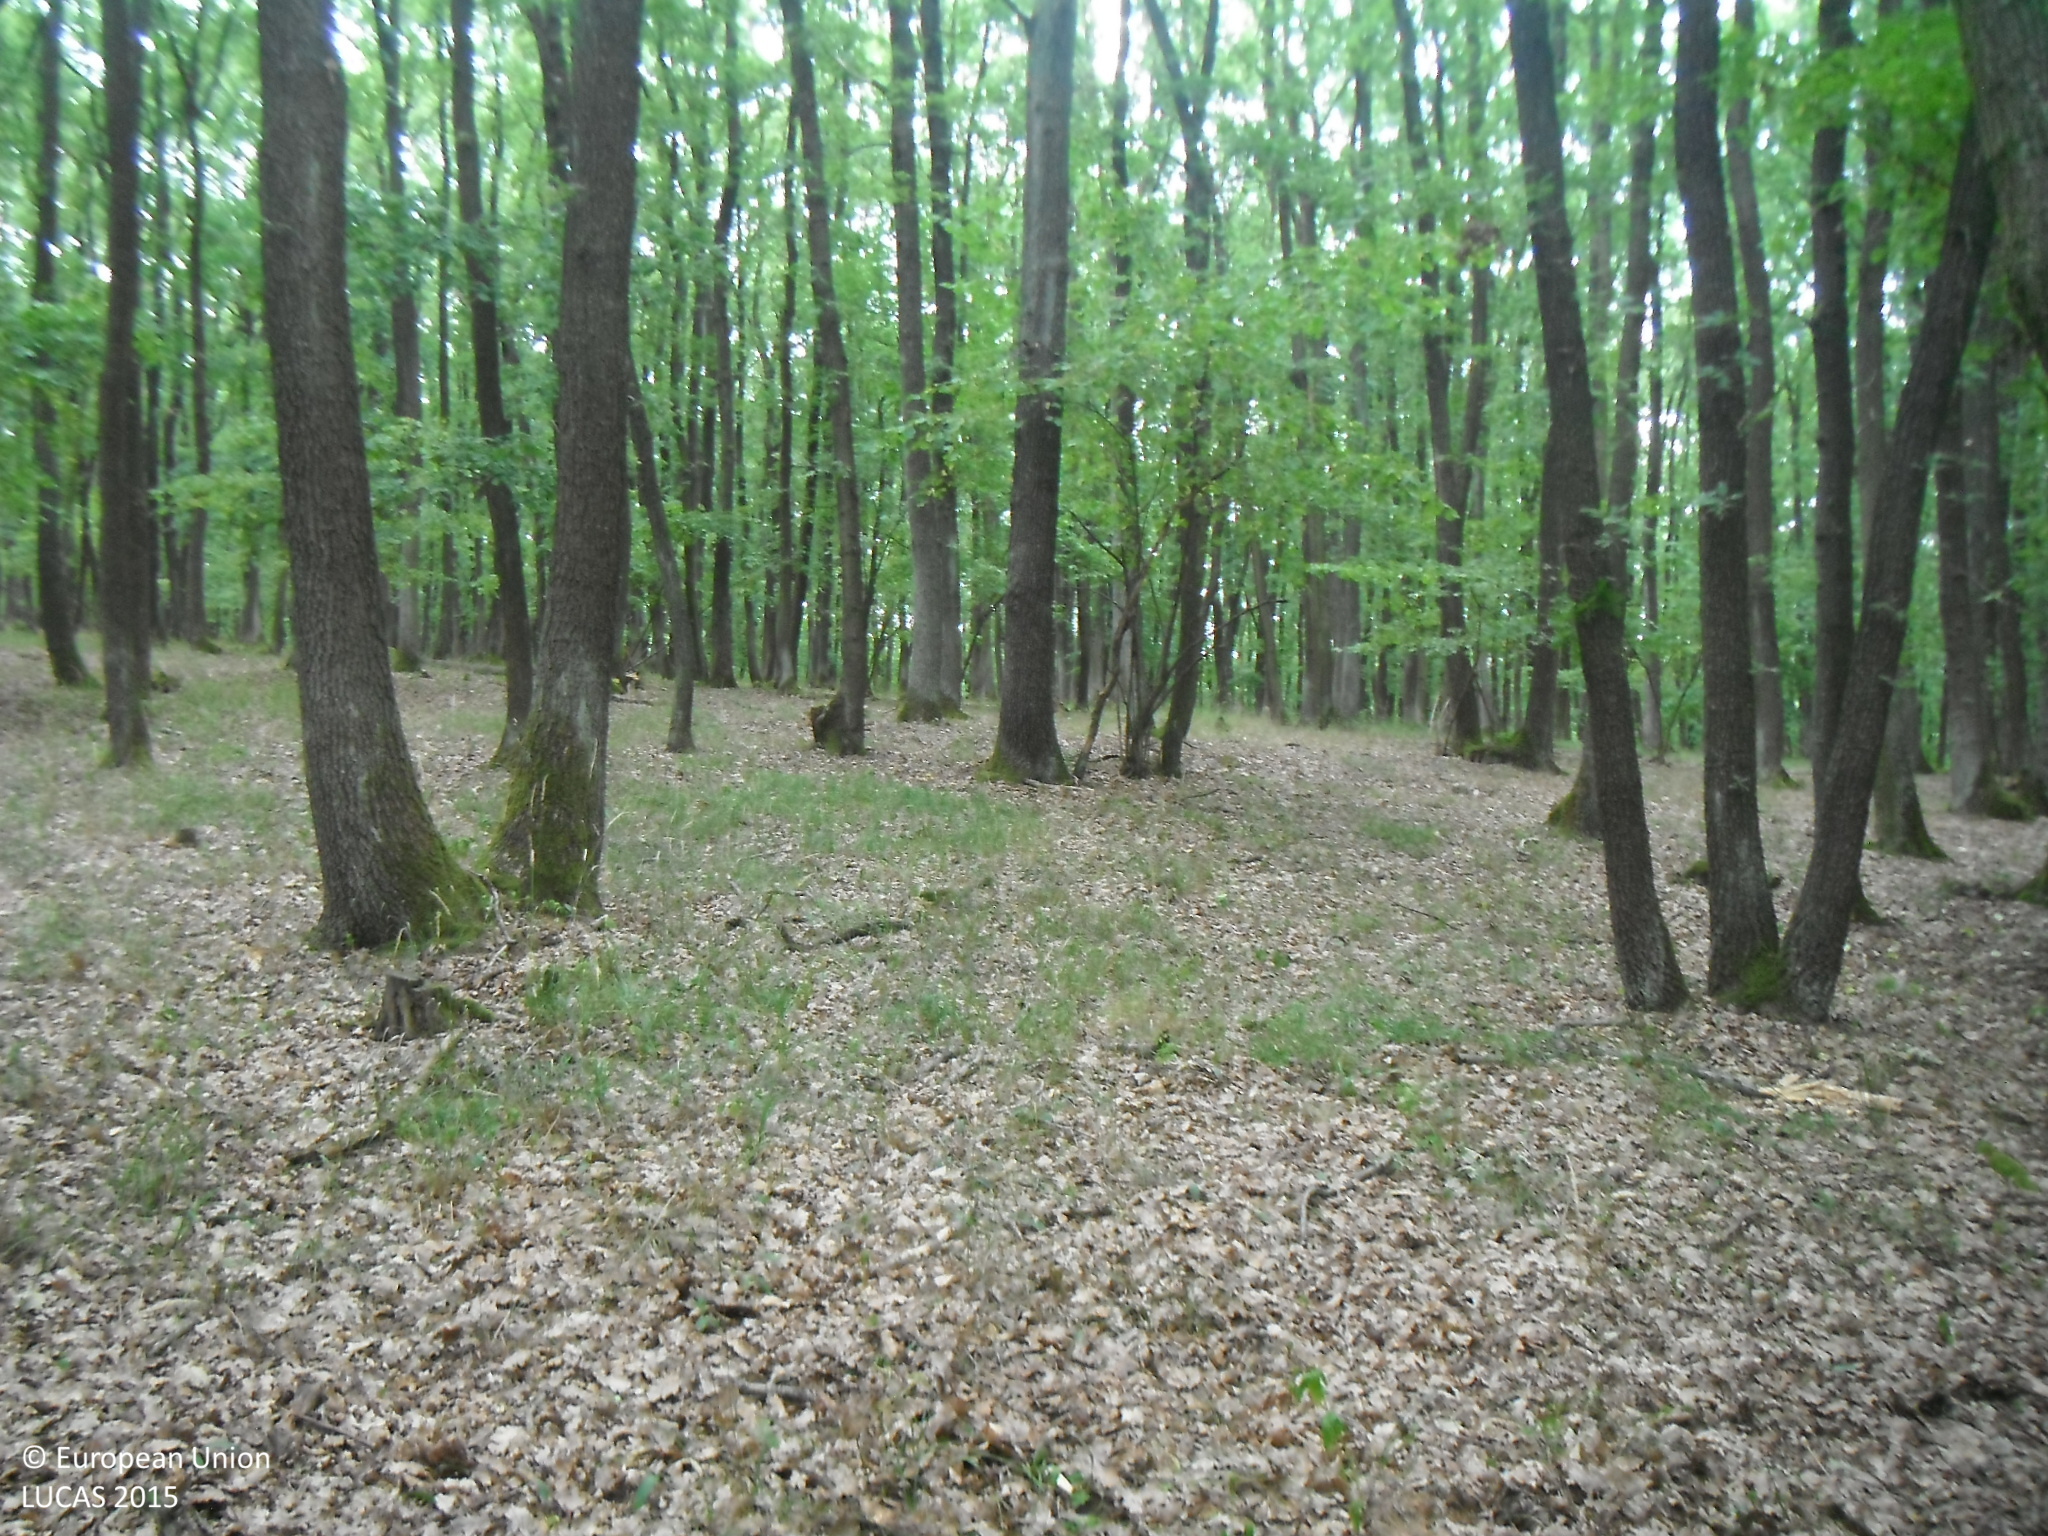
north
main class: Woodland
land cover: Broadleaved woodland
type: mesophytic deciduous forest
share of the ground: > 75 %
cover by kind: broadleaved forest trees 90 %, herbaceous plants 5 %, unconsolidated bare surface 5 %
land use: Forestry
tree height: > 5 m
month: July
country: SK
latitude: 48.7965
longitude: 17.2659
